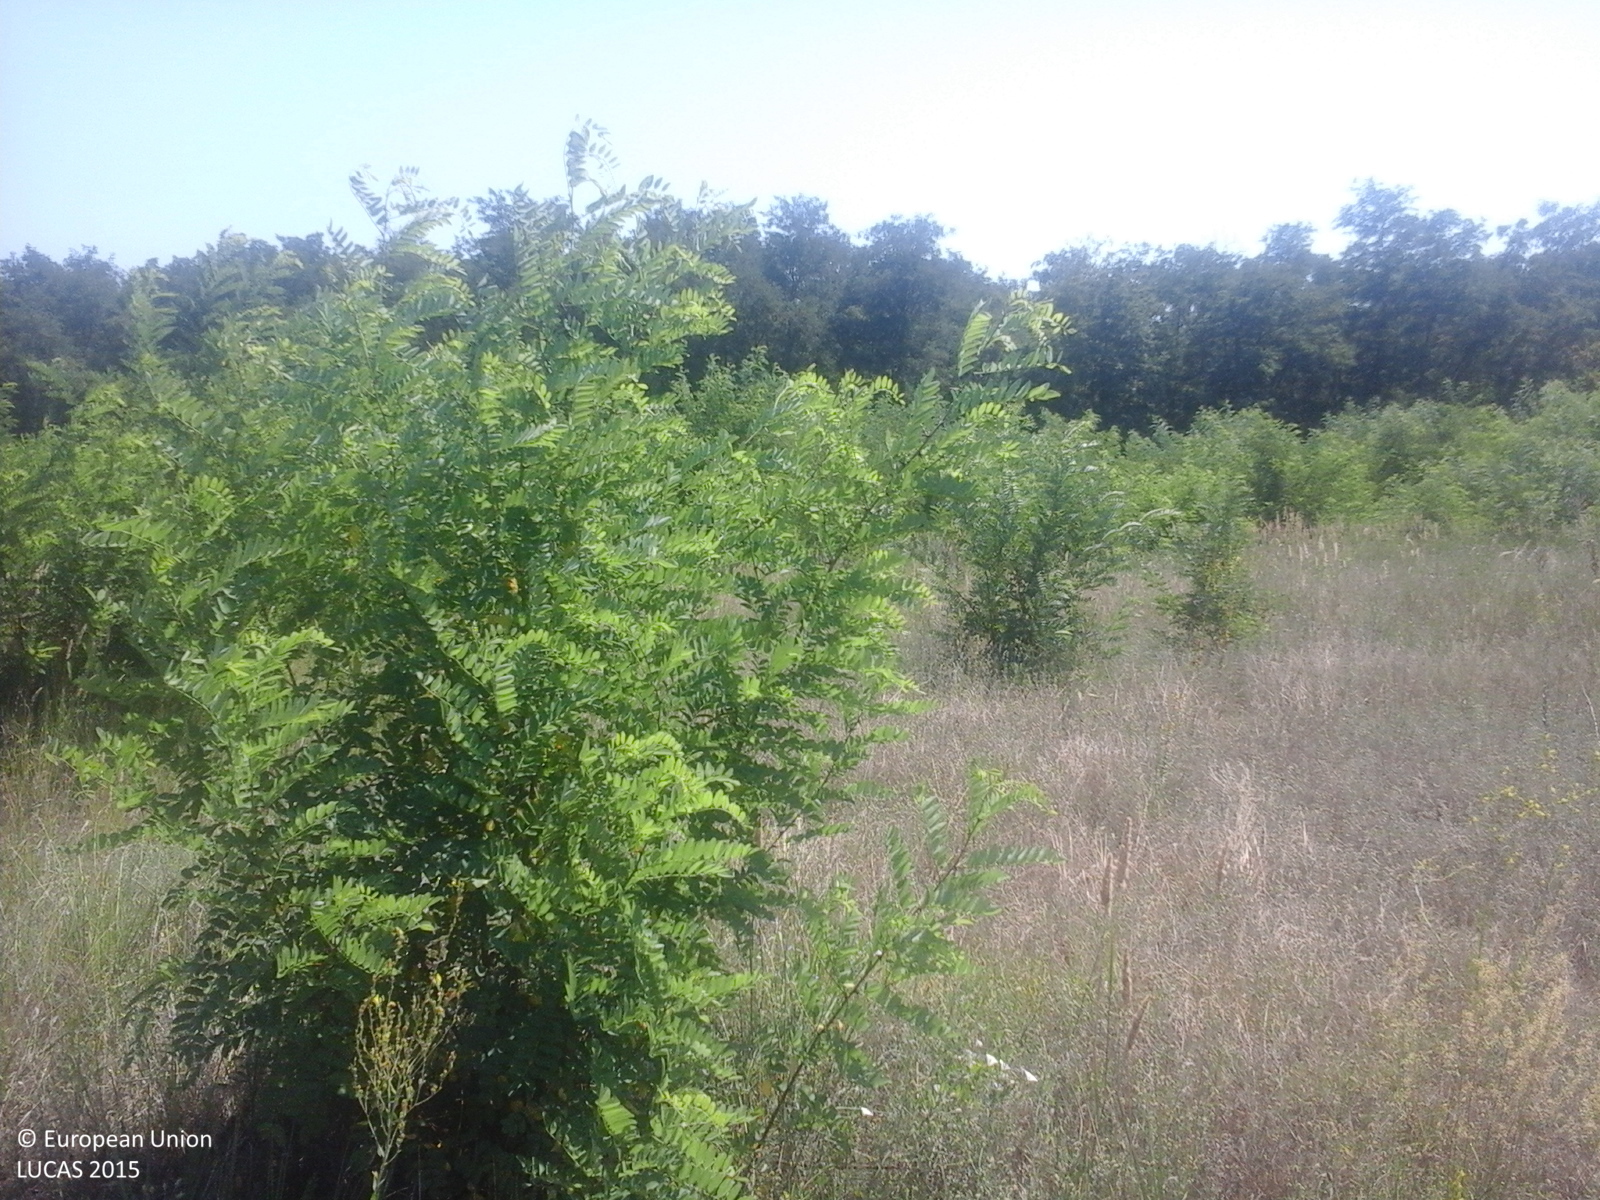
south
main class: Grassland
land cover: Grassland with sparse tree/shrub cover
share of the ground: > 75 %
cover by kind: herbaceous plants 85 %, shrubs 10 %, broadleaved forest trees 5 %
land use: Agriculture (excluding fallow land and kitchen gardens)
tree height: < 5 m
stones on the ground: < 10 %
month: July
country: RO
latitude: 44.8589
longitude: 27.7052
